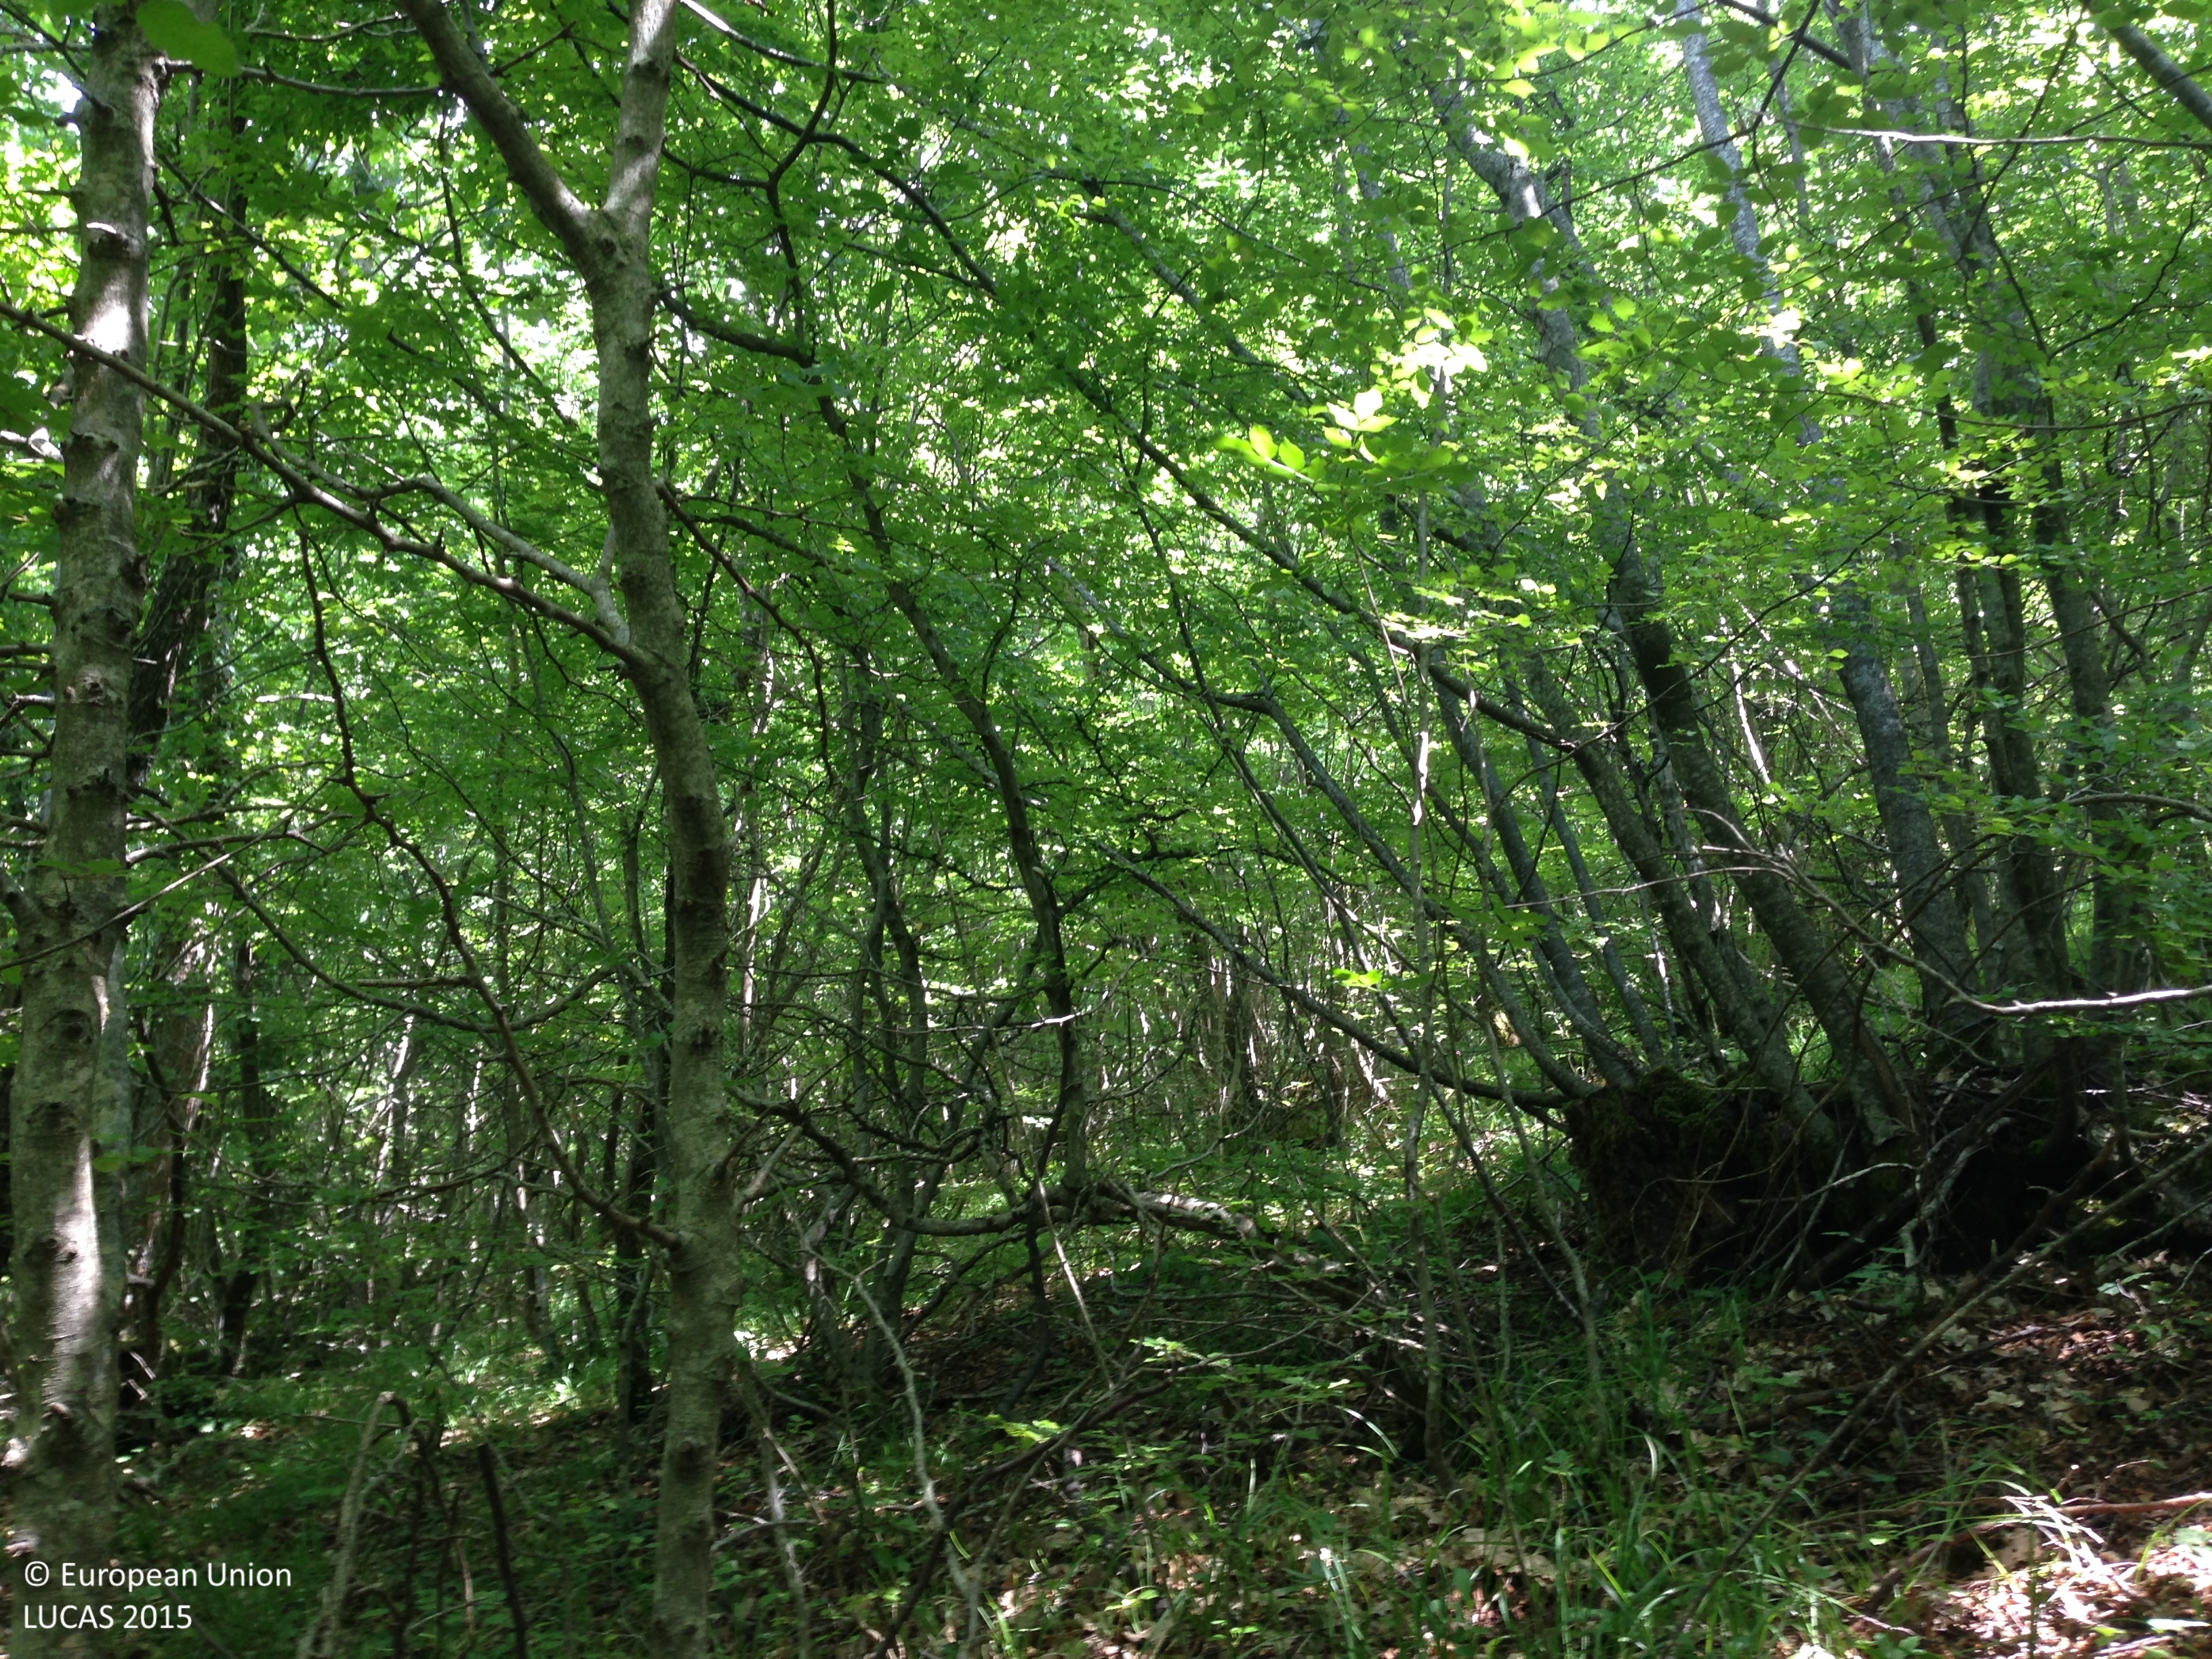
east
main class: Woodland
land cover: Broadleaved woodland
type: thermophilous deciduous forest
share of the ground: > 75 %
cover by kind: broadleaved forest trees 75 %, shrubs 10 %, herbaceous plants 5 %, consolidated bare surface 5 %, unconsolidated bare surface 5 %
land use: Semi-natural and natural areas not in use
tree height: > 5 m
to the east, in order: Broadleaved woodland; Dry stone walls; Broadleaved woodland; Dry stone walls; Broadleaved woodland
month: June
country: HR
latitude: 43.7331
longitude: 16.4601
